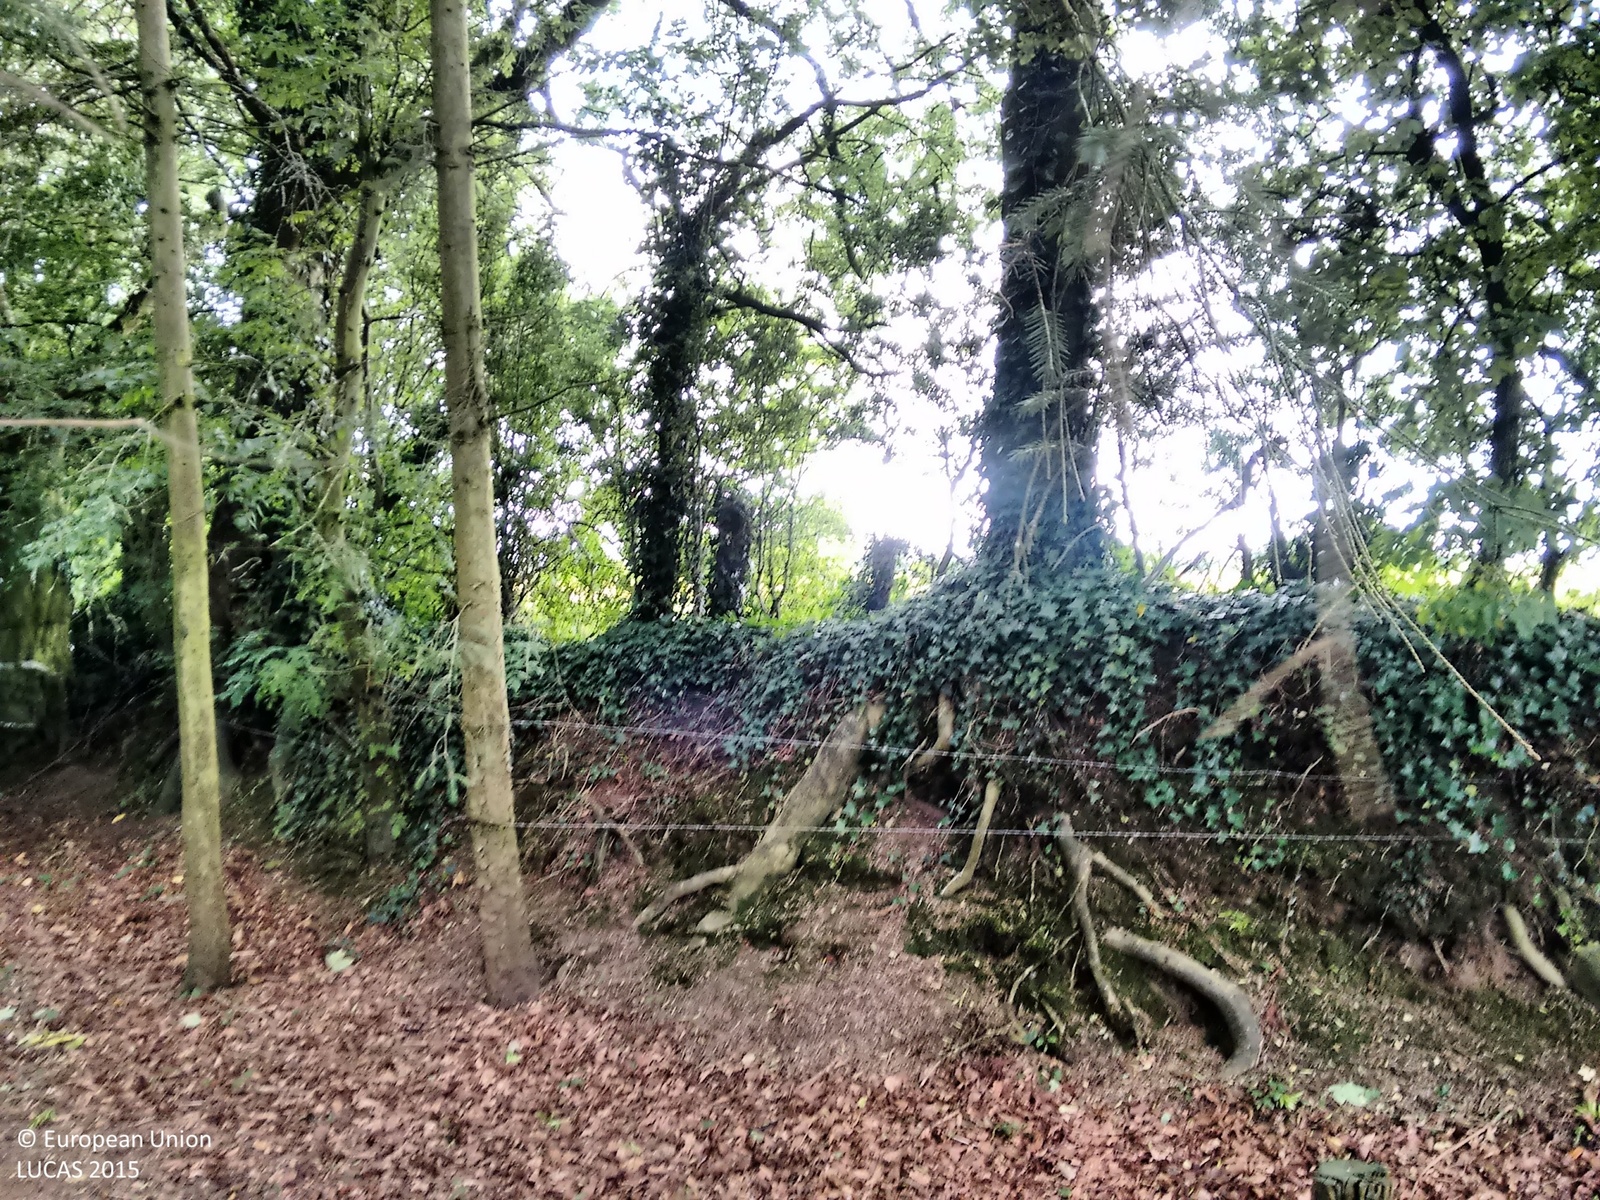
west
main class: Woodland
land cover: Spruce dominated coniferous woodland
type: hemiboreal forest and nemoral coniferous forest and mixed broadleaved-coniferous forest
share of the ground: > 75 %
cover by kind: coniferous forest trees 85 %, broadleaved forest trees 10 %, shrubs 5 %
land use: Residential
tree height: > 5 m
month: July
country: IE
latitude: 52.8265
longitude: -6.7725
